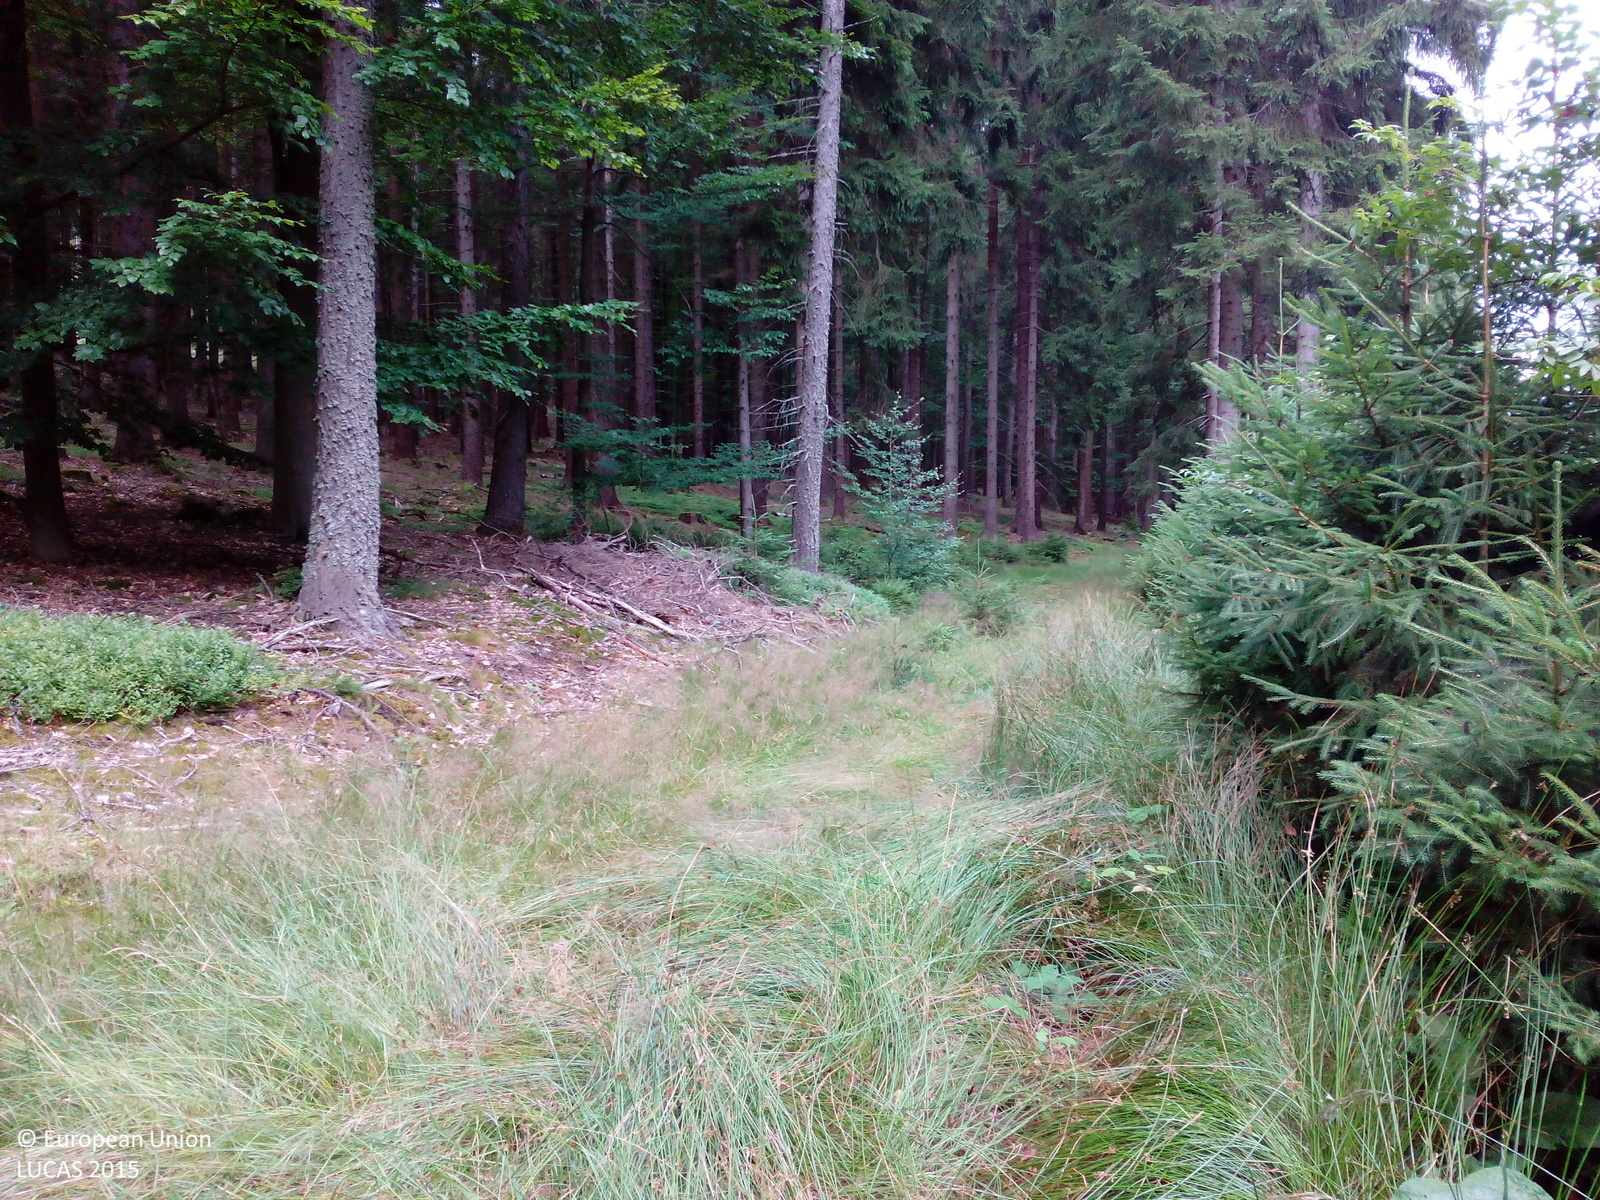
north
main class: Woodland
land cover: Spruce dominated mixed woodland
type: hemiboreal forest and nemoral coniferous forest and mixed broadleaved-coniferous forest
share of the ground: > 75 %
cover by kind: coniferous forest trees 50 %, broadleaved forest trees 25 %, herbaceous plants 15 %, shrubs 10 %
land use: Forestry
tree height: < 5 m
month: July
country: DE
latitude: 49.7817
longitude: 12.3745
